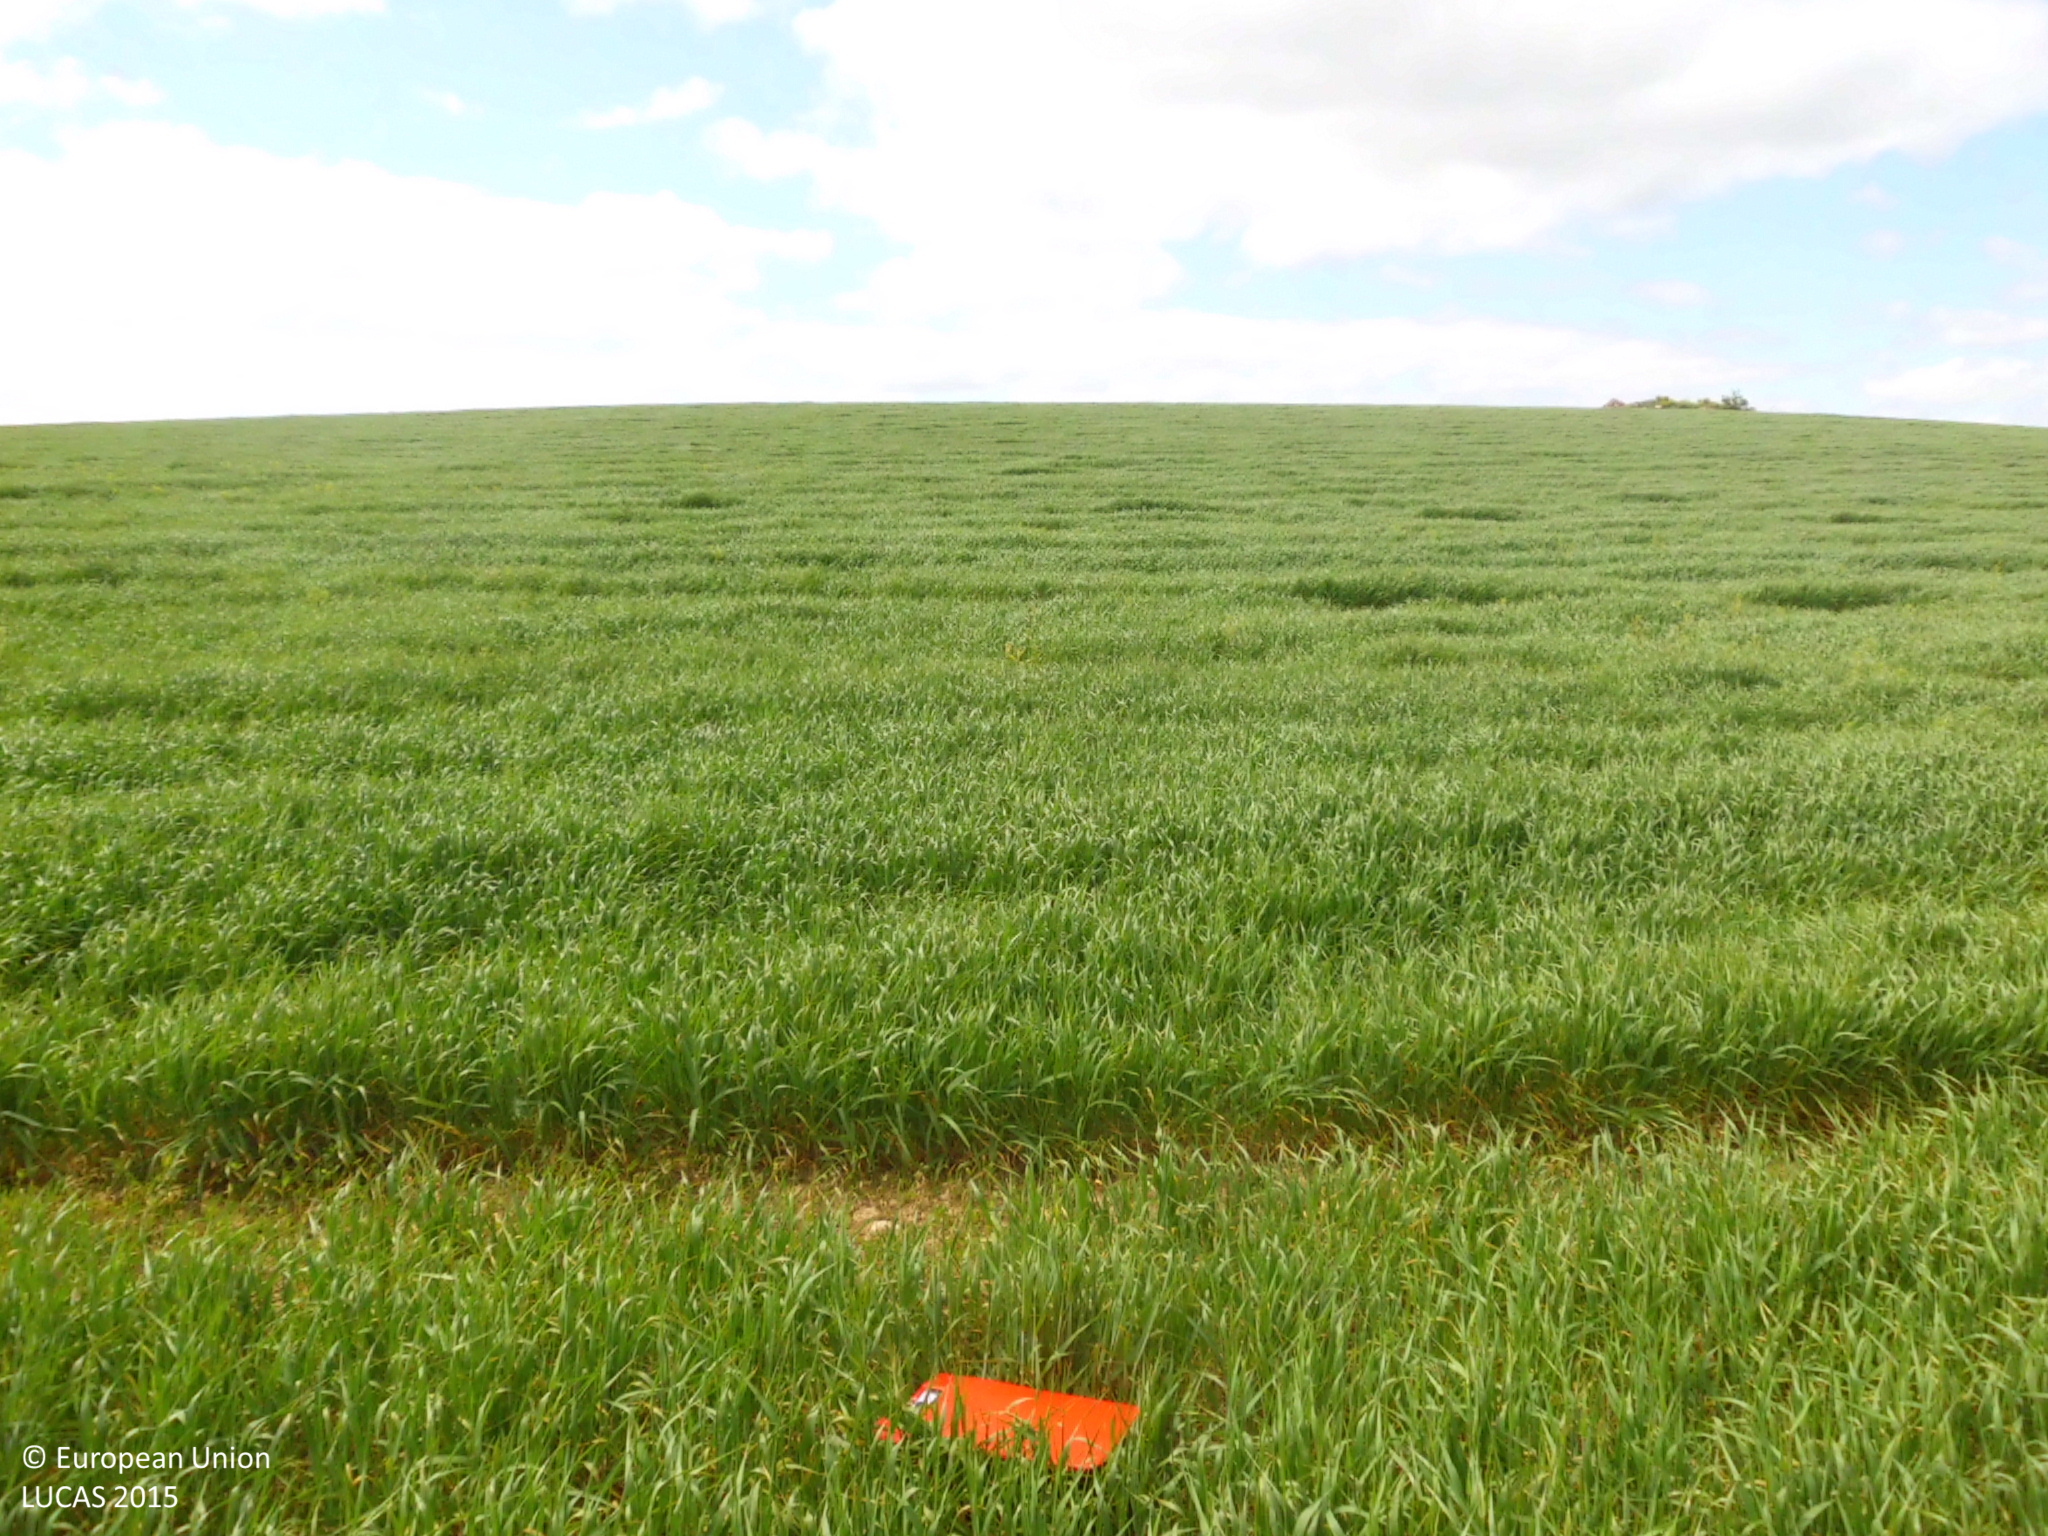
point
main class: Cropland
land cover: Barley
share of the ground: > 75 %
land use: Agriculture (excluding fallow land and kitchen gardens)
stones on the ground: 10 - 25 %
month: May
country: ES
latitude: 42.3648
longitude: -3.9186
